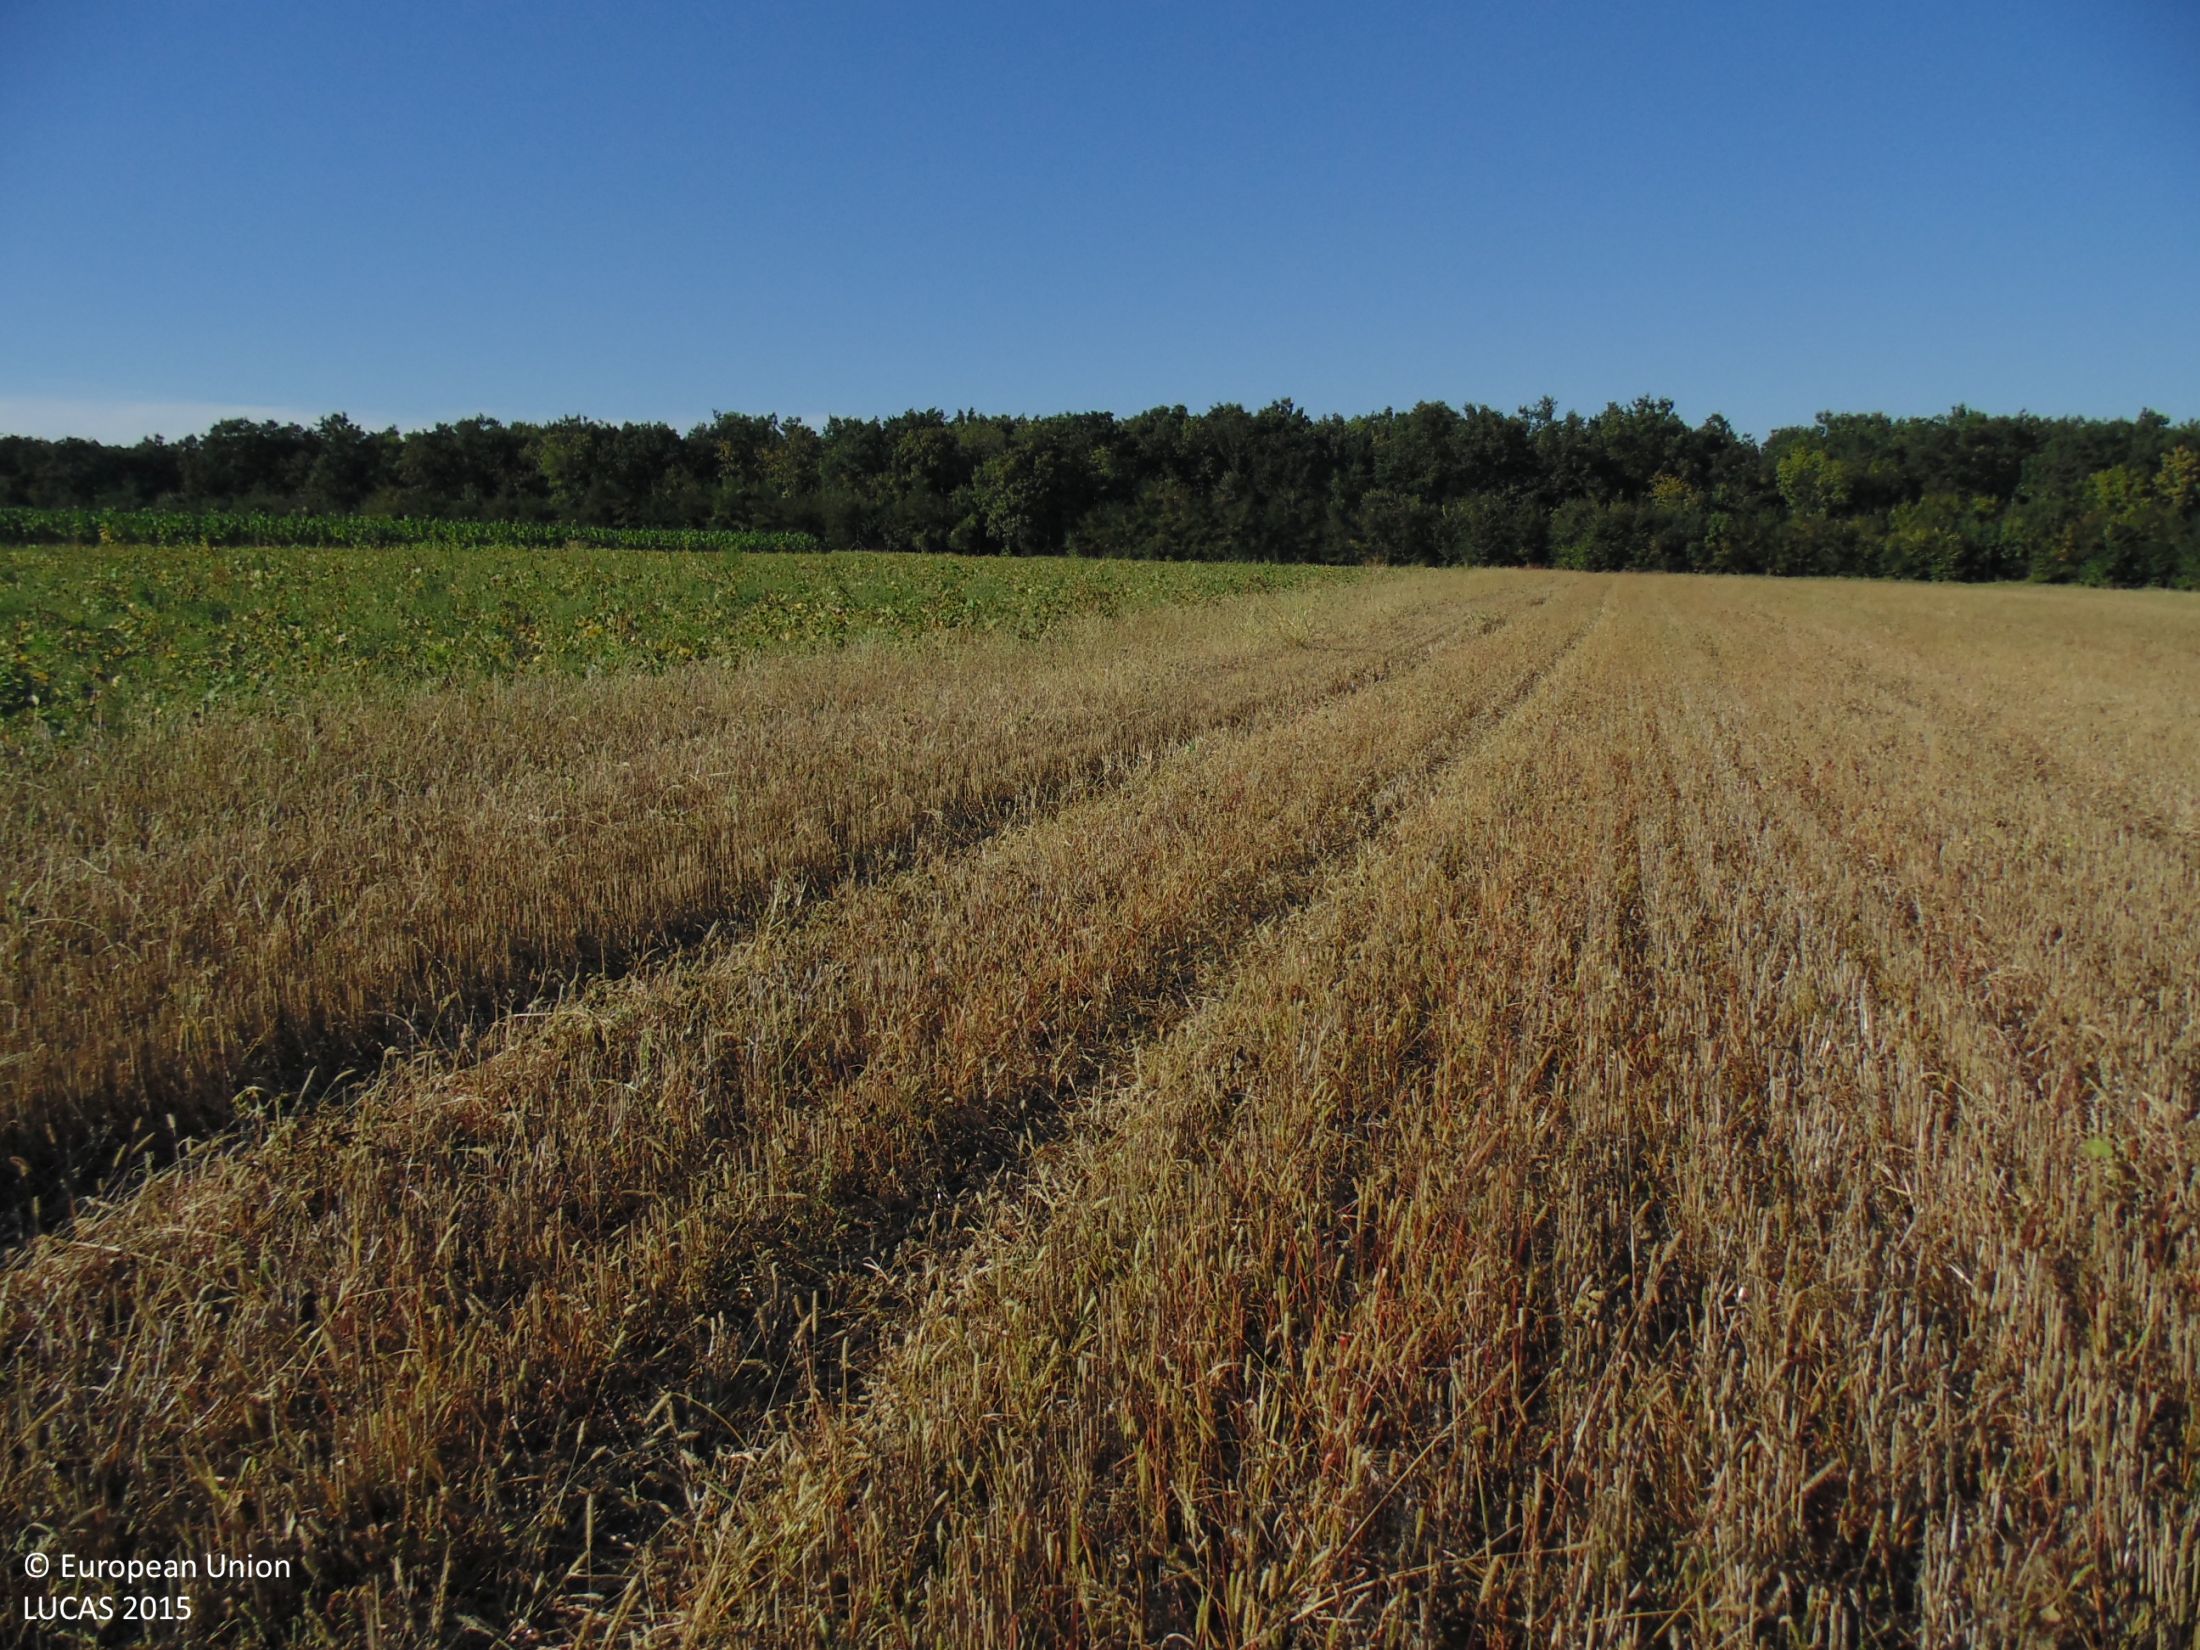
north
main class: Cropland
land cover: Common wheat
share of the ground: 25 - 50 %
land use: Agriculture (excluding fallow land and kitchen gardens)
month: September
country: BG
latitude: 43.8588
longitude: 26.9792
